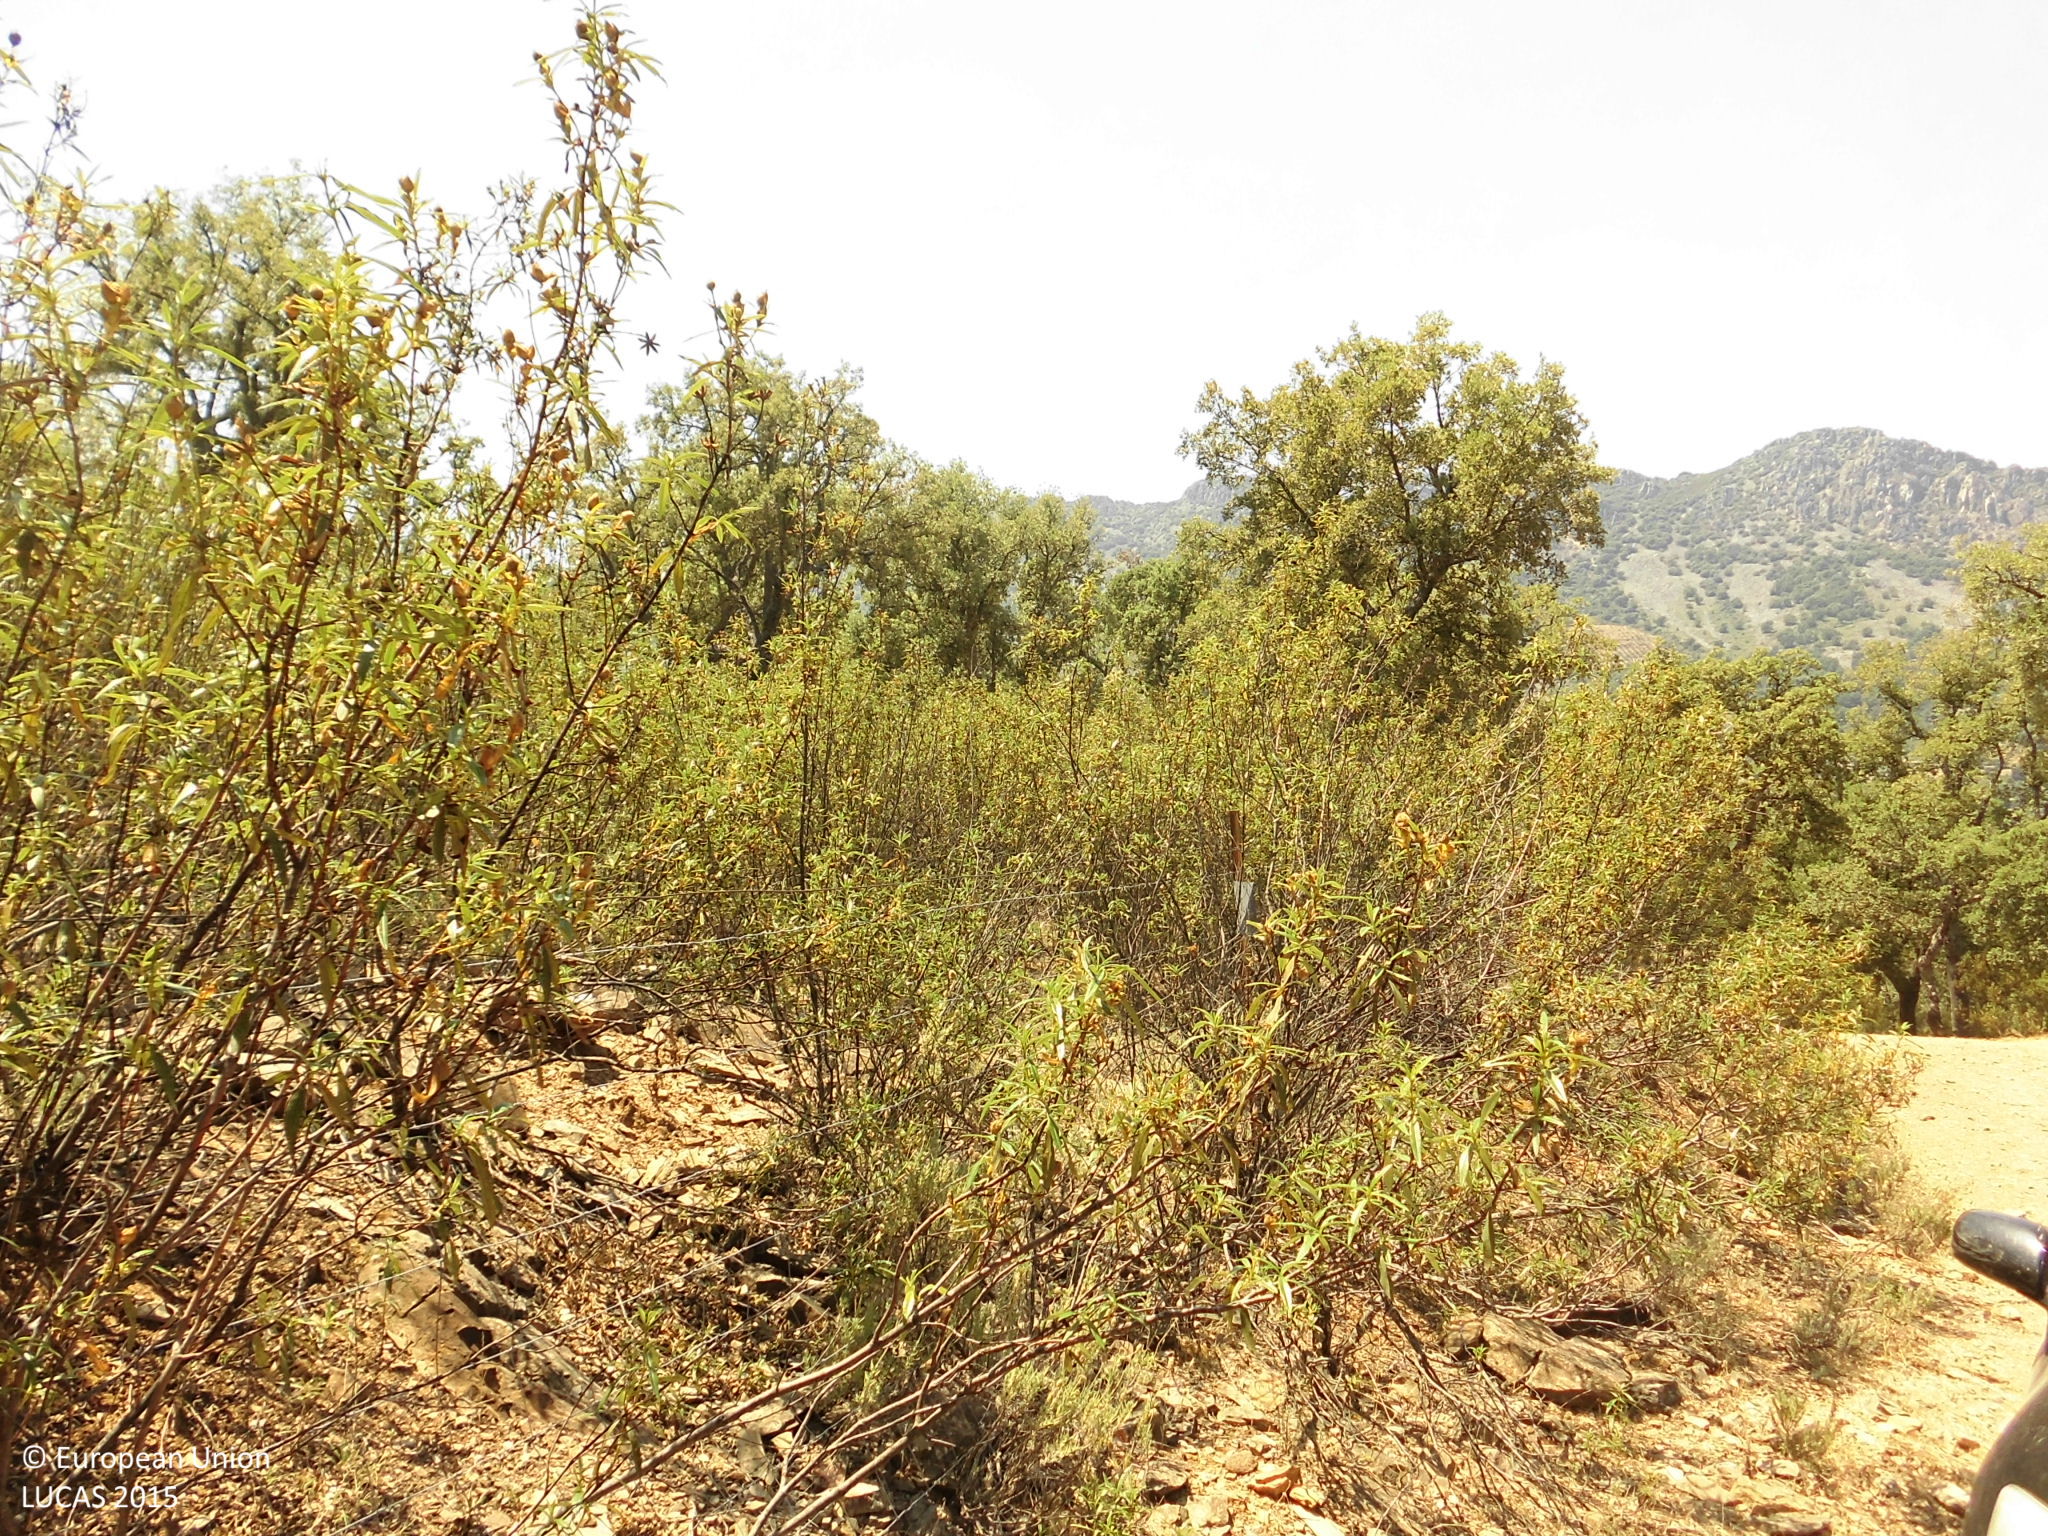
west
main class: Woodland
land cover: Broadleaved woodland
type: broadleaved evergreen forest
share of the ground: 10 - 25 %
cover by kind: herbaceous plants 60 %, shrubs 25 %, broadleaved forest trees 15 %
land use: Forestry
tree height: > 5 m
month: June
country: ES
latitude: 39.5612
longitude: -5.3796
